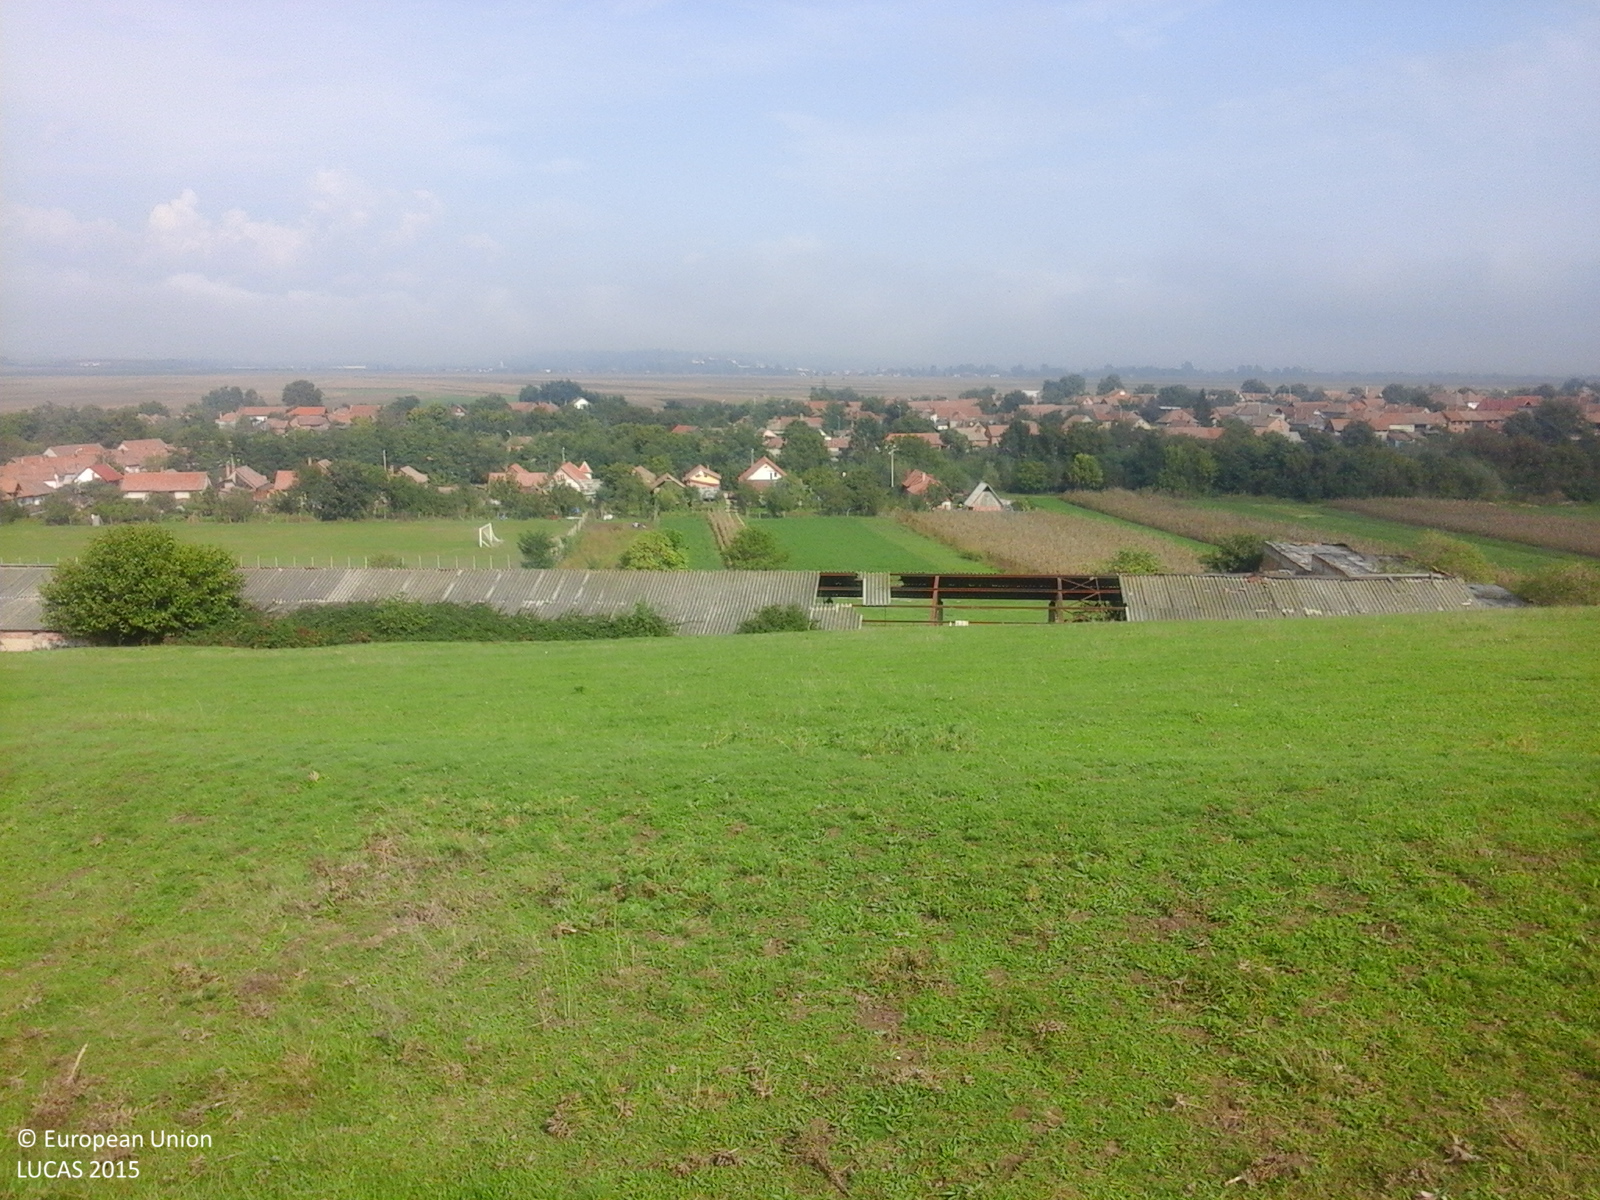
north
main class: Grassland
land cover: Grassland without tree/shrub cover
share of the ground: > 75 %
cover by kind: herbaceous plants 100 %
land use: Agriculture (excluding fallow land and kitchen gardens)
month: October
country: RO
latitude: 46.1501
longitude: 23.6237
